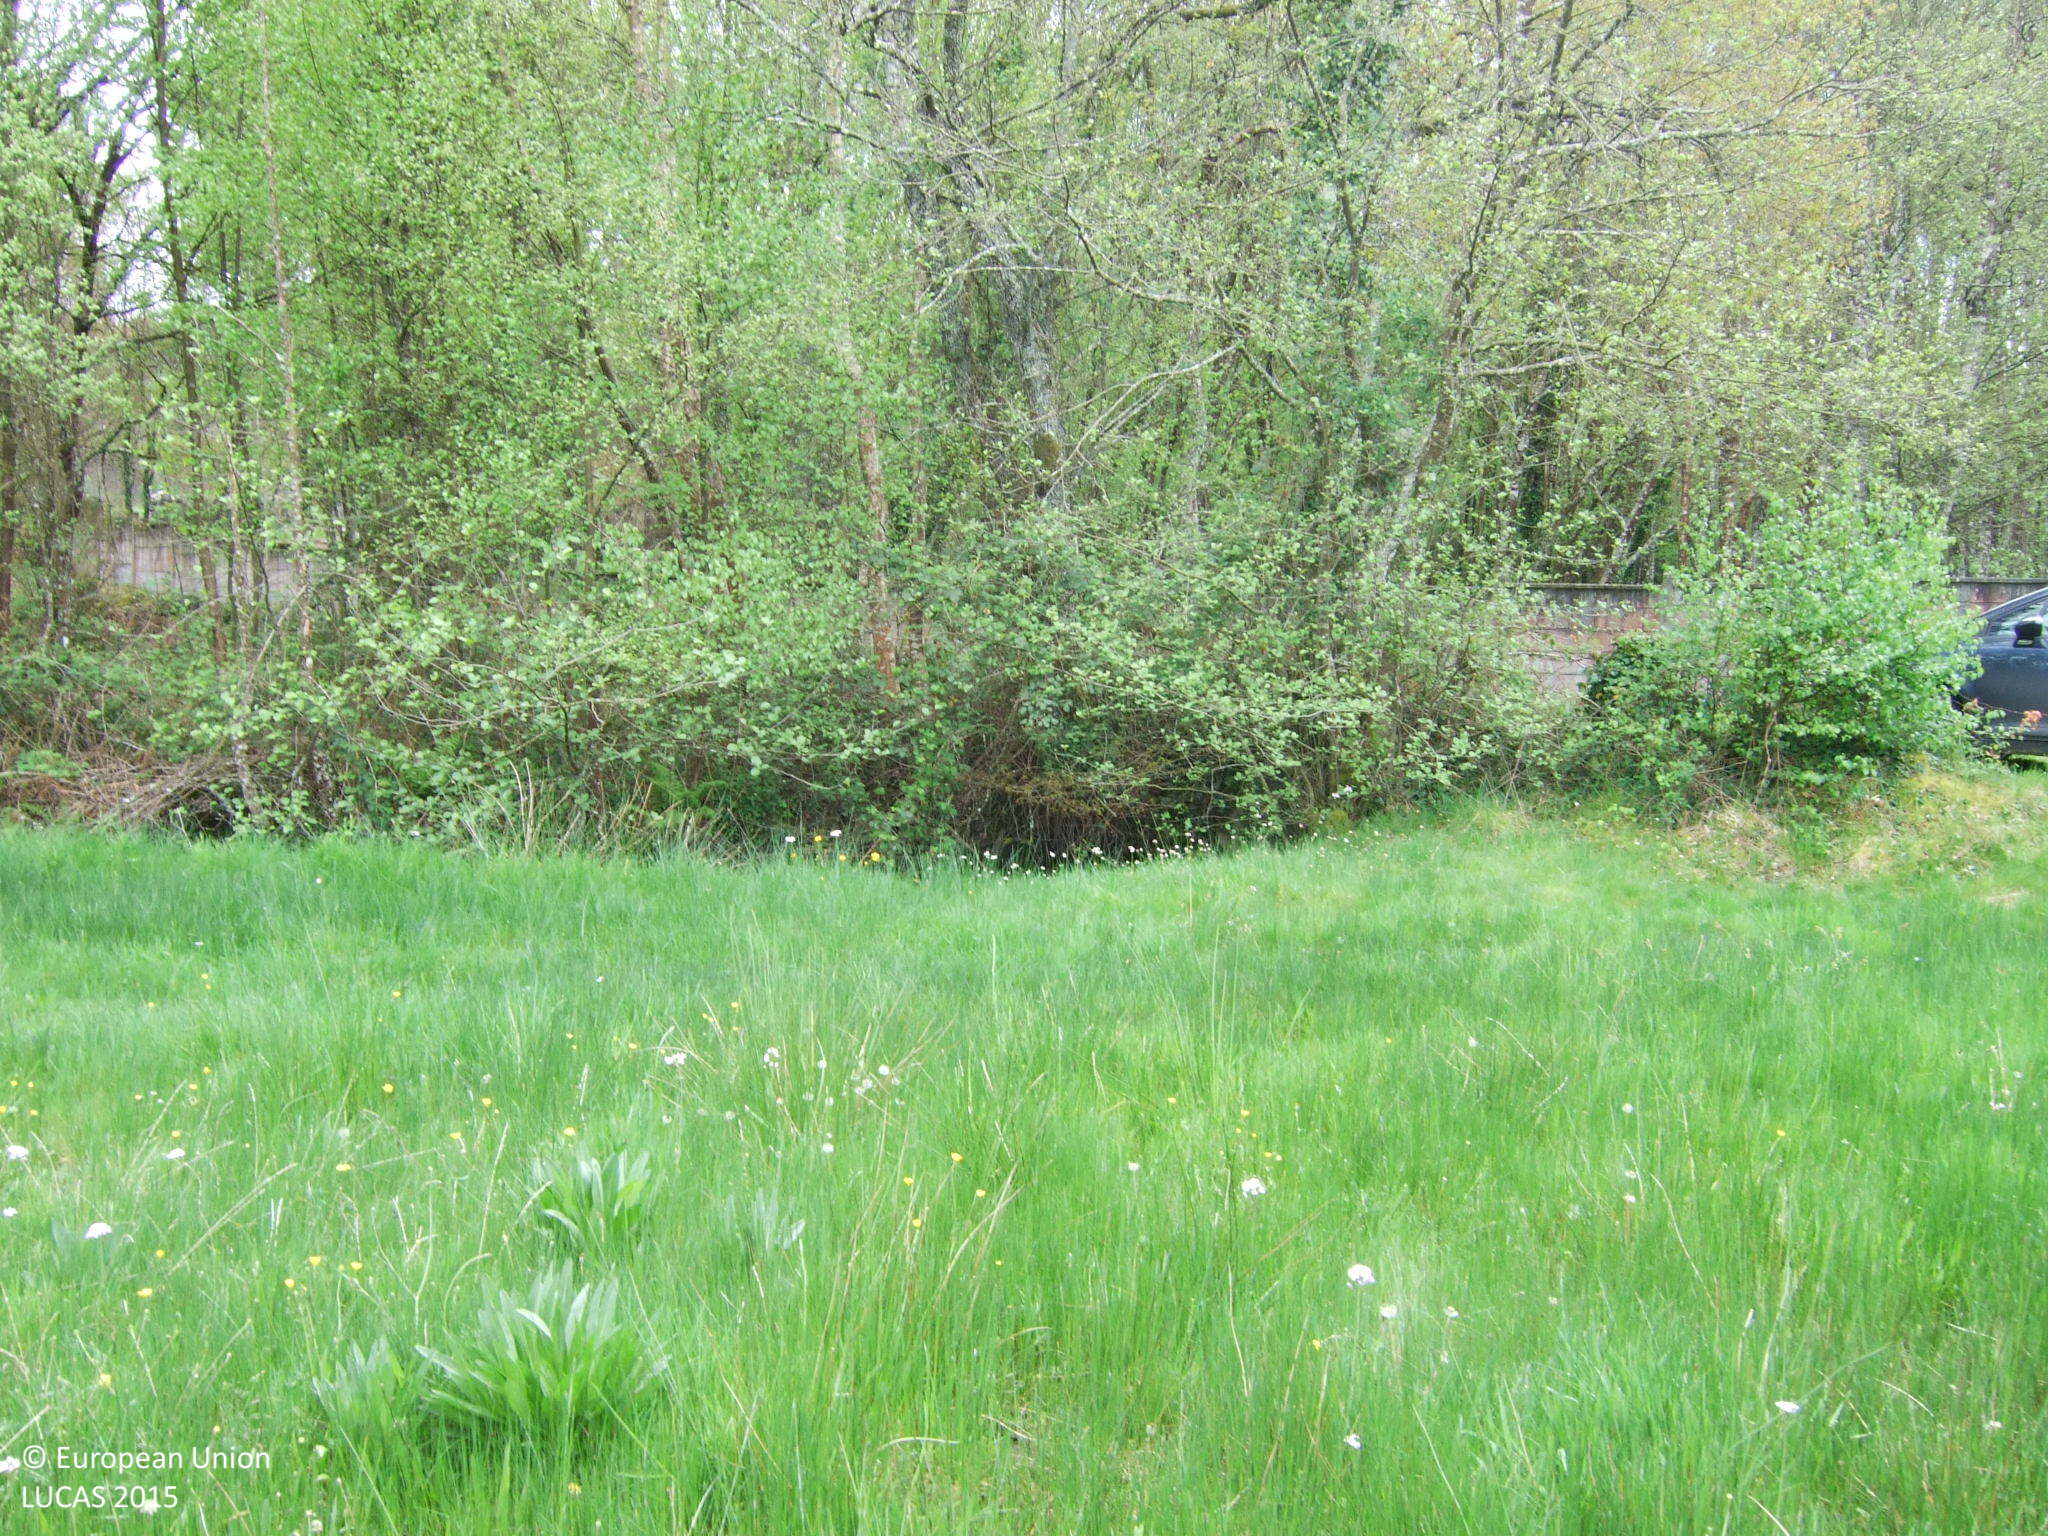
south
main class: Grassland
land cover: Grassland without tree/shrub cover
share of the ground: > 75 %
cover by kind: herbaceous plants 100 %
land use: Agriculture (excluding fallow land and kitchen gardens)
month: April
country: ES
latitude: 43.1146
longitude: -7.6681
